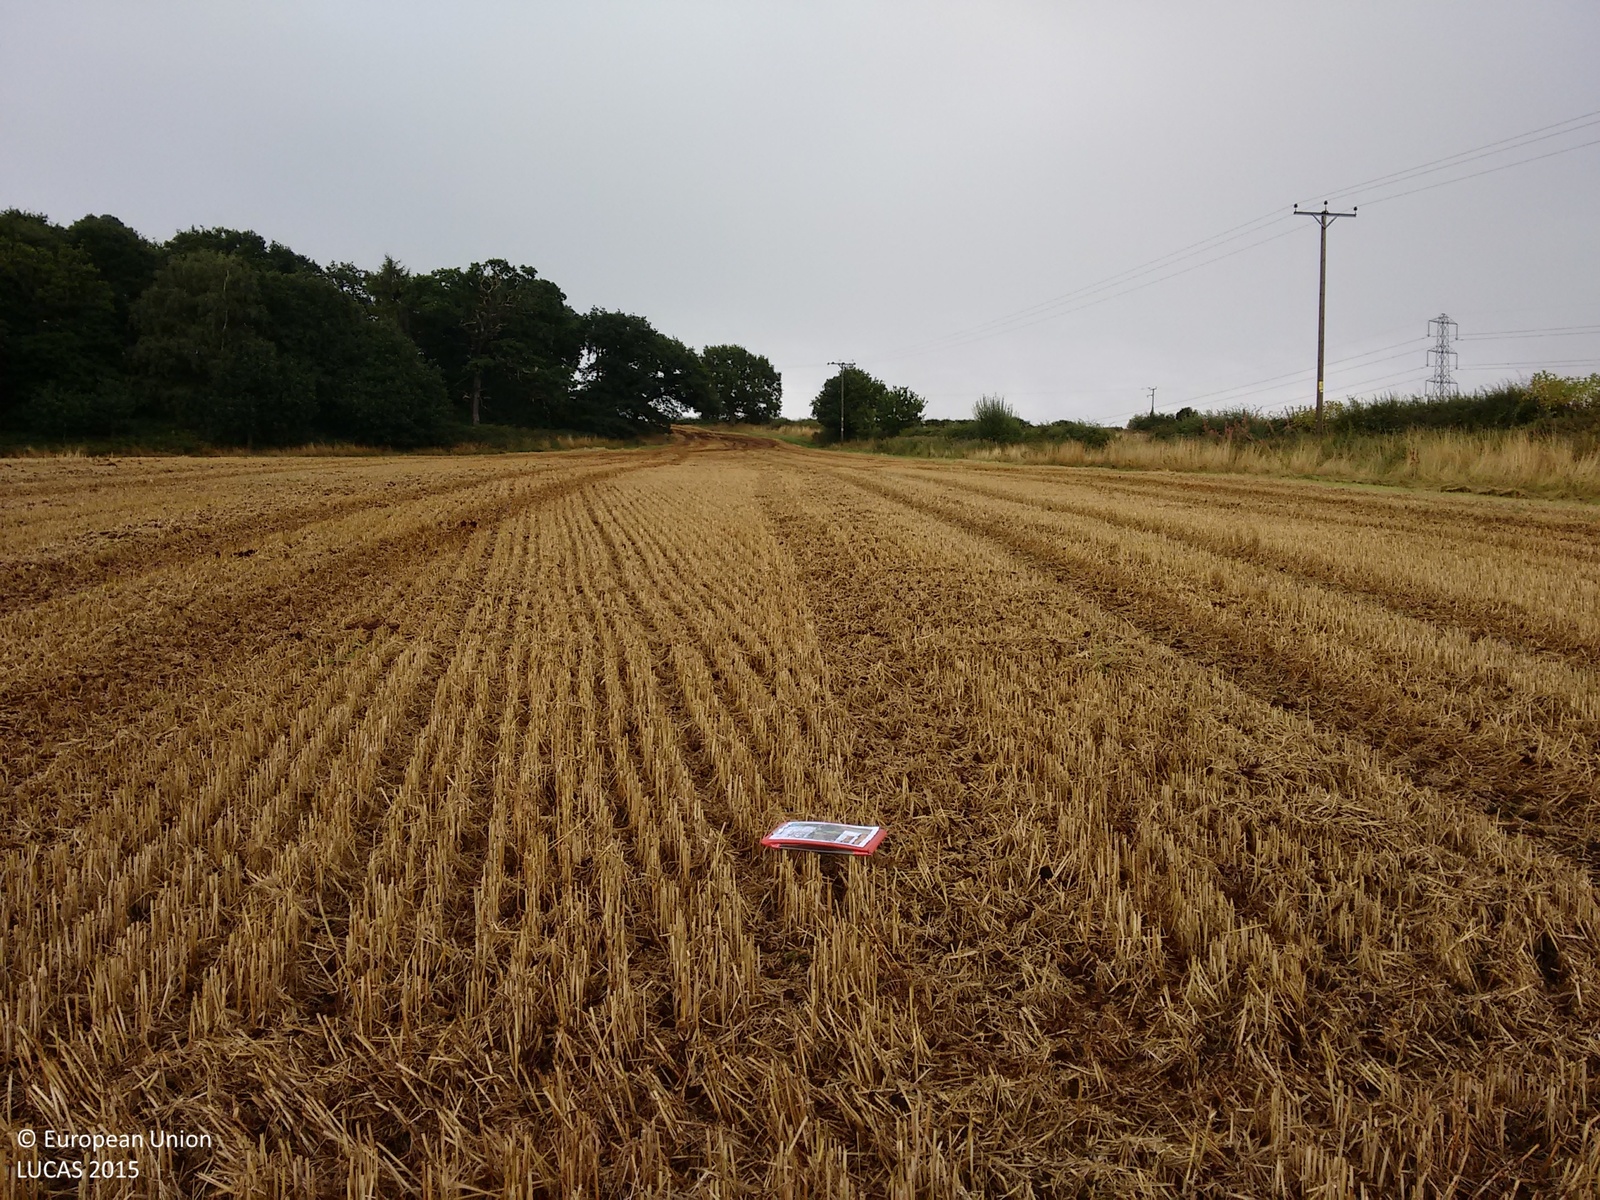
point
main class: Cropland
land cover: Common wheat
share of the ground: > 75 %
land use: Agriculture (excluding fallow land and kitchen gardens)
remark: Harvested field
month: September
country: GB
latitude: 52.8371
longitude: -1.4658
